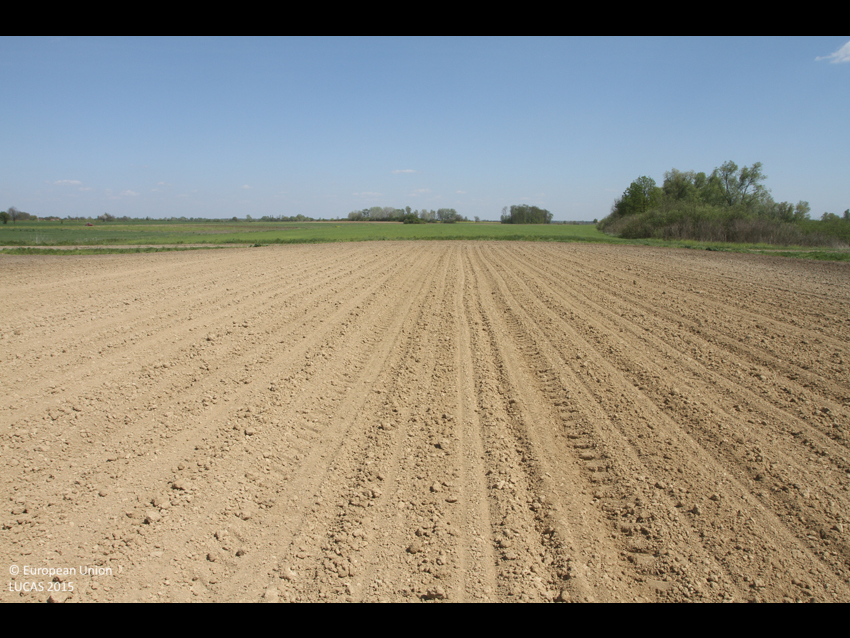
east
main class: Cropland
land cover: Soya
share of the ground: < 10 %
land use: Agriculture (excluding fallow land and kitchen gardens)
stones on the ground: < 10 %
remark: Tilled/Sowed
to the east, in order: Soya; Ditches and canals; Tracks; Grass margins; Ditches and canals; Common wheat
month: April
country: HR
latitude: 44.8738
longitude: 18.9045
